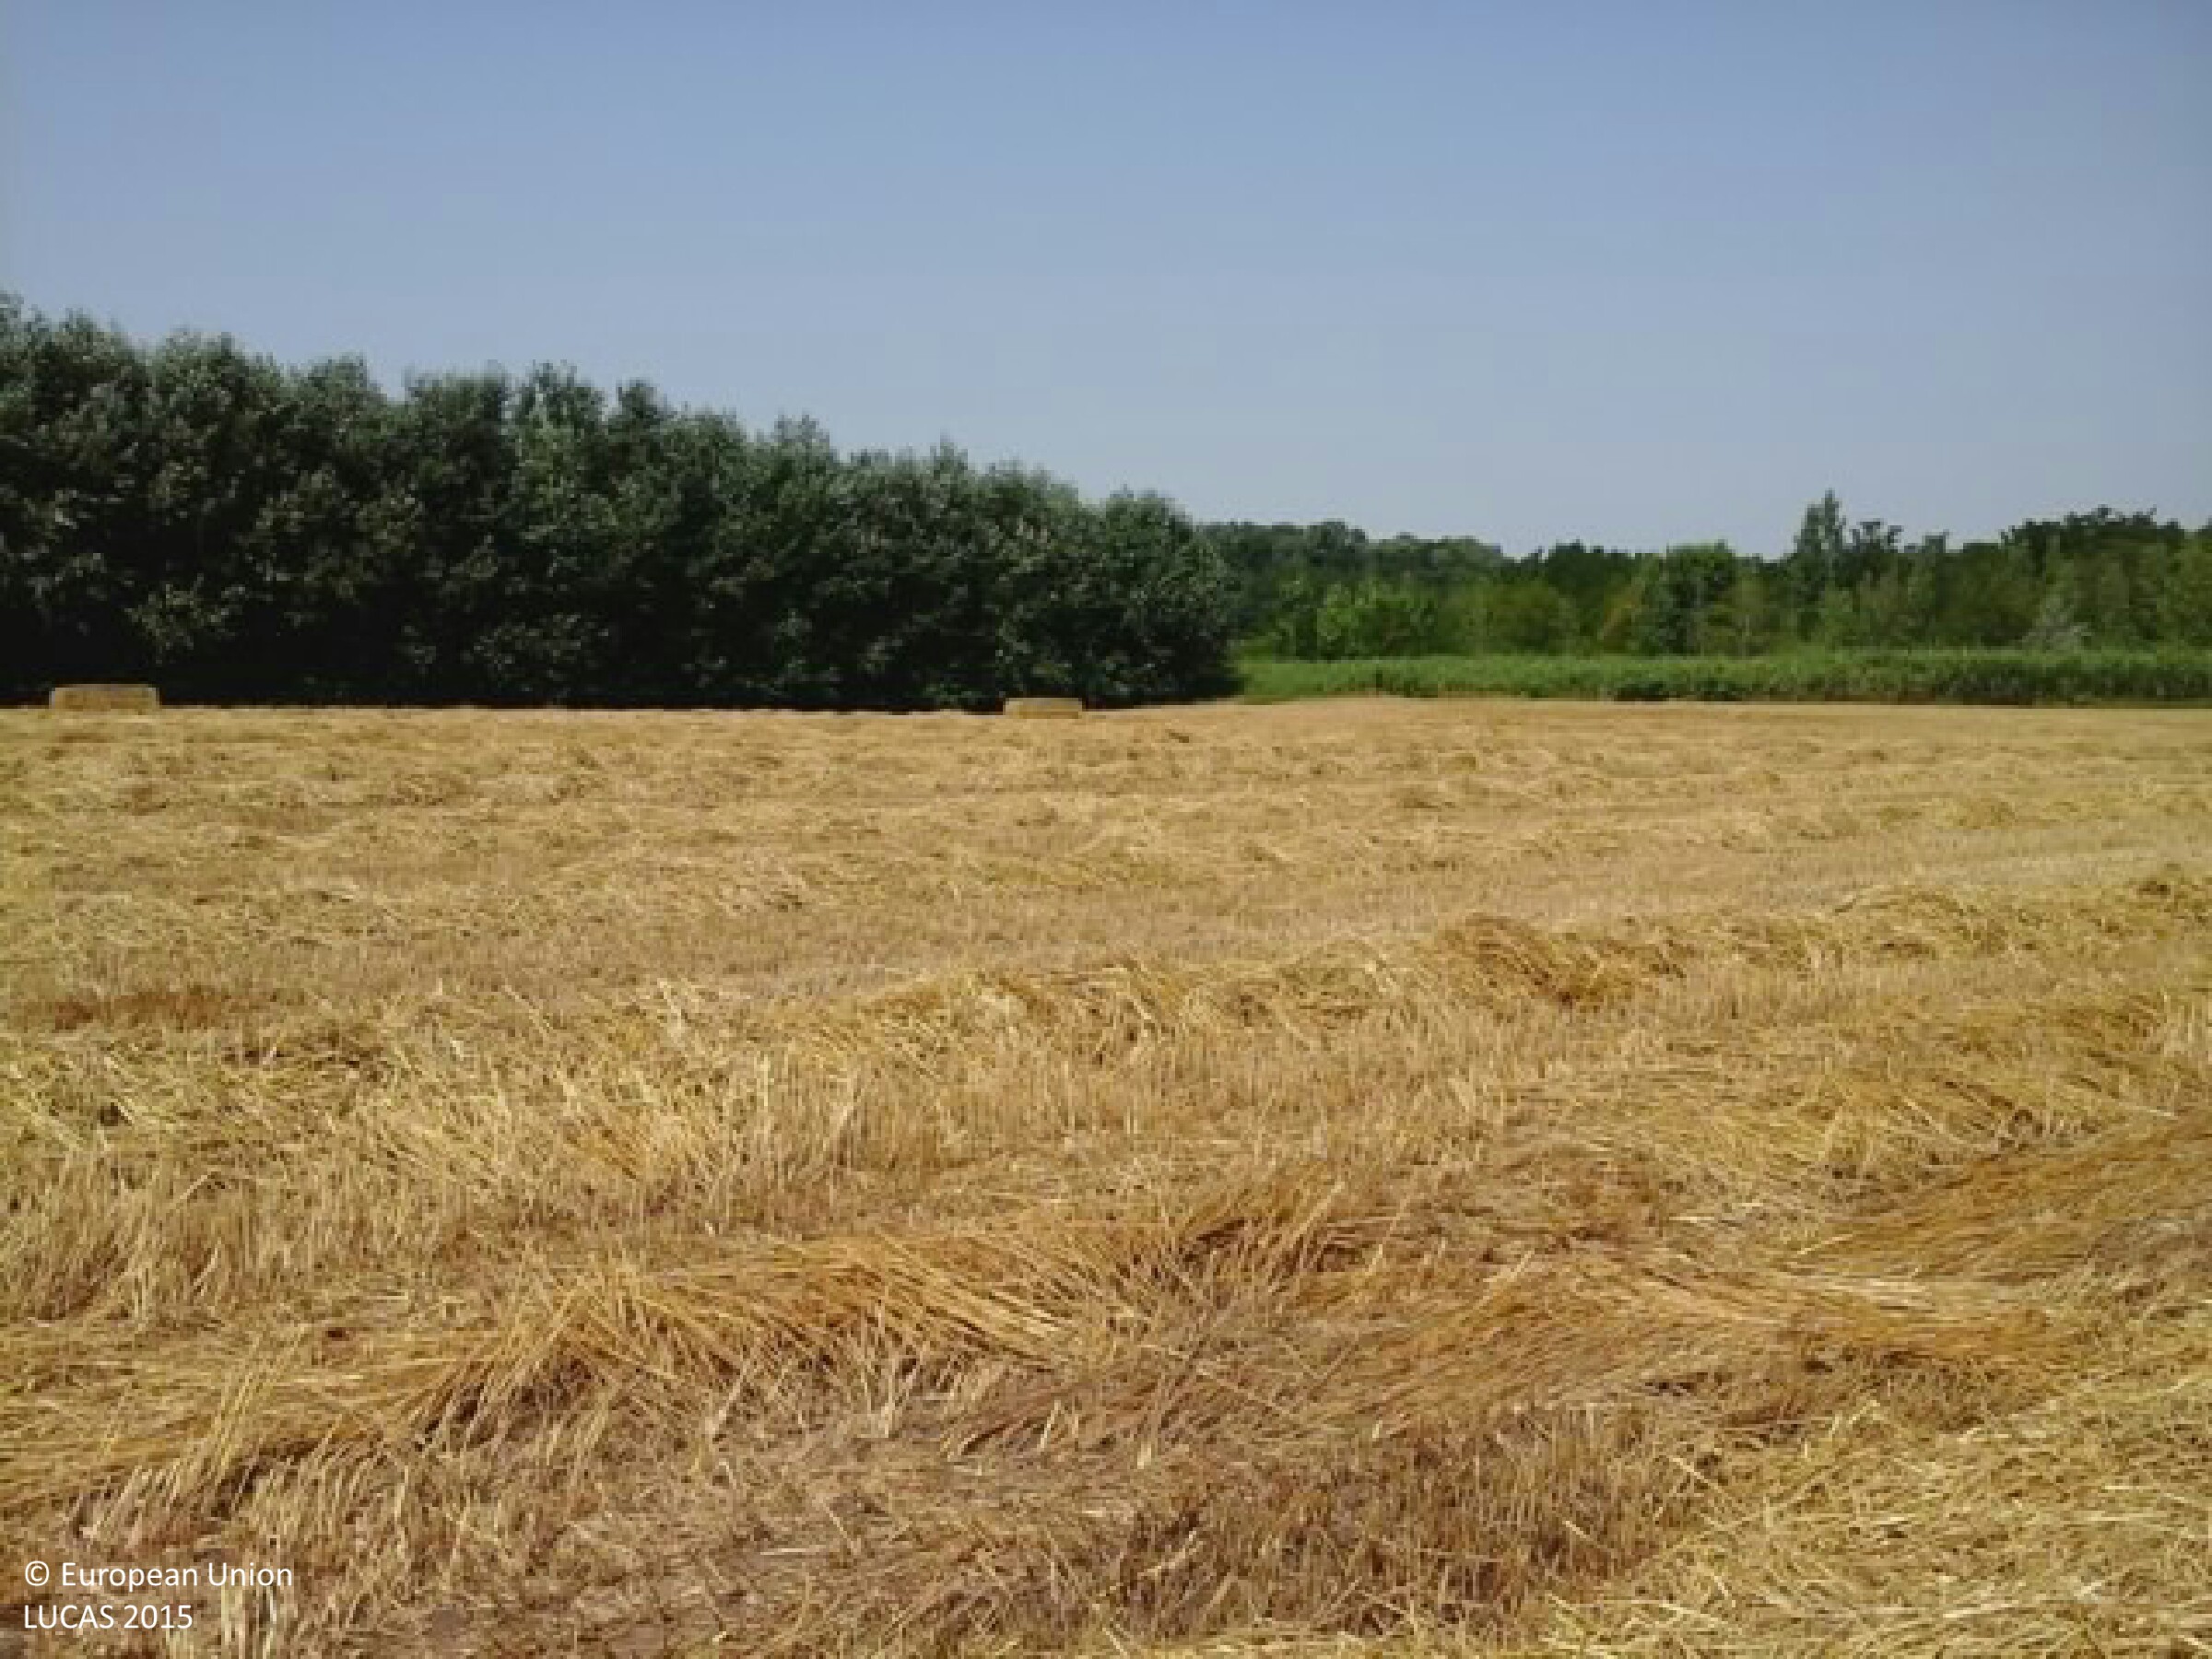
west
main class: Cropland
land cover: Common wheat
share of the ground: 50 - 75 %
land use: Agriculture (excluding fallow land and kitchen gardens)
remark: Harvested field
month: July
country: HU
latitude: 46.3664
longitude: 21.1466
